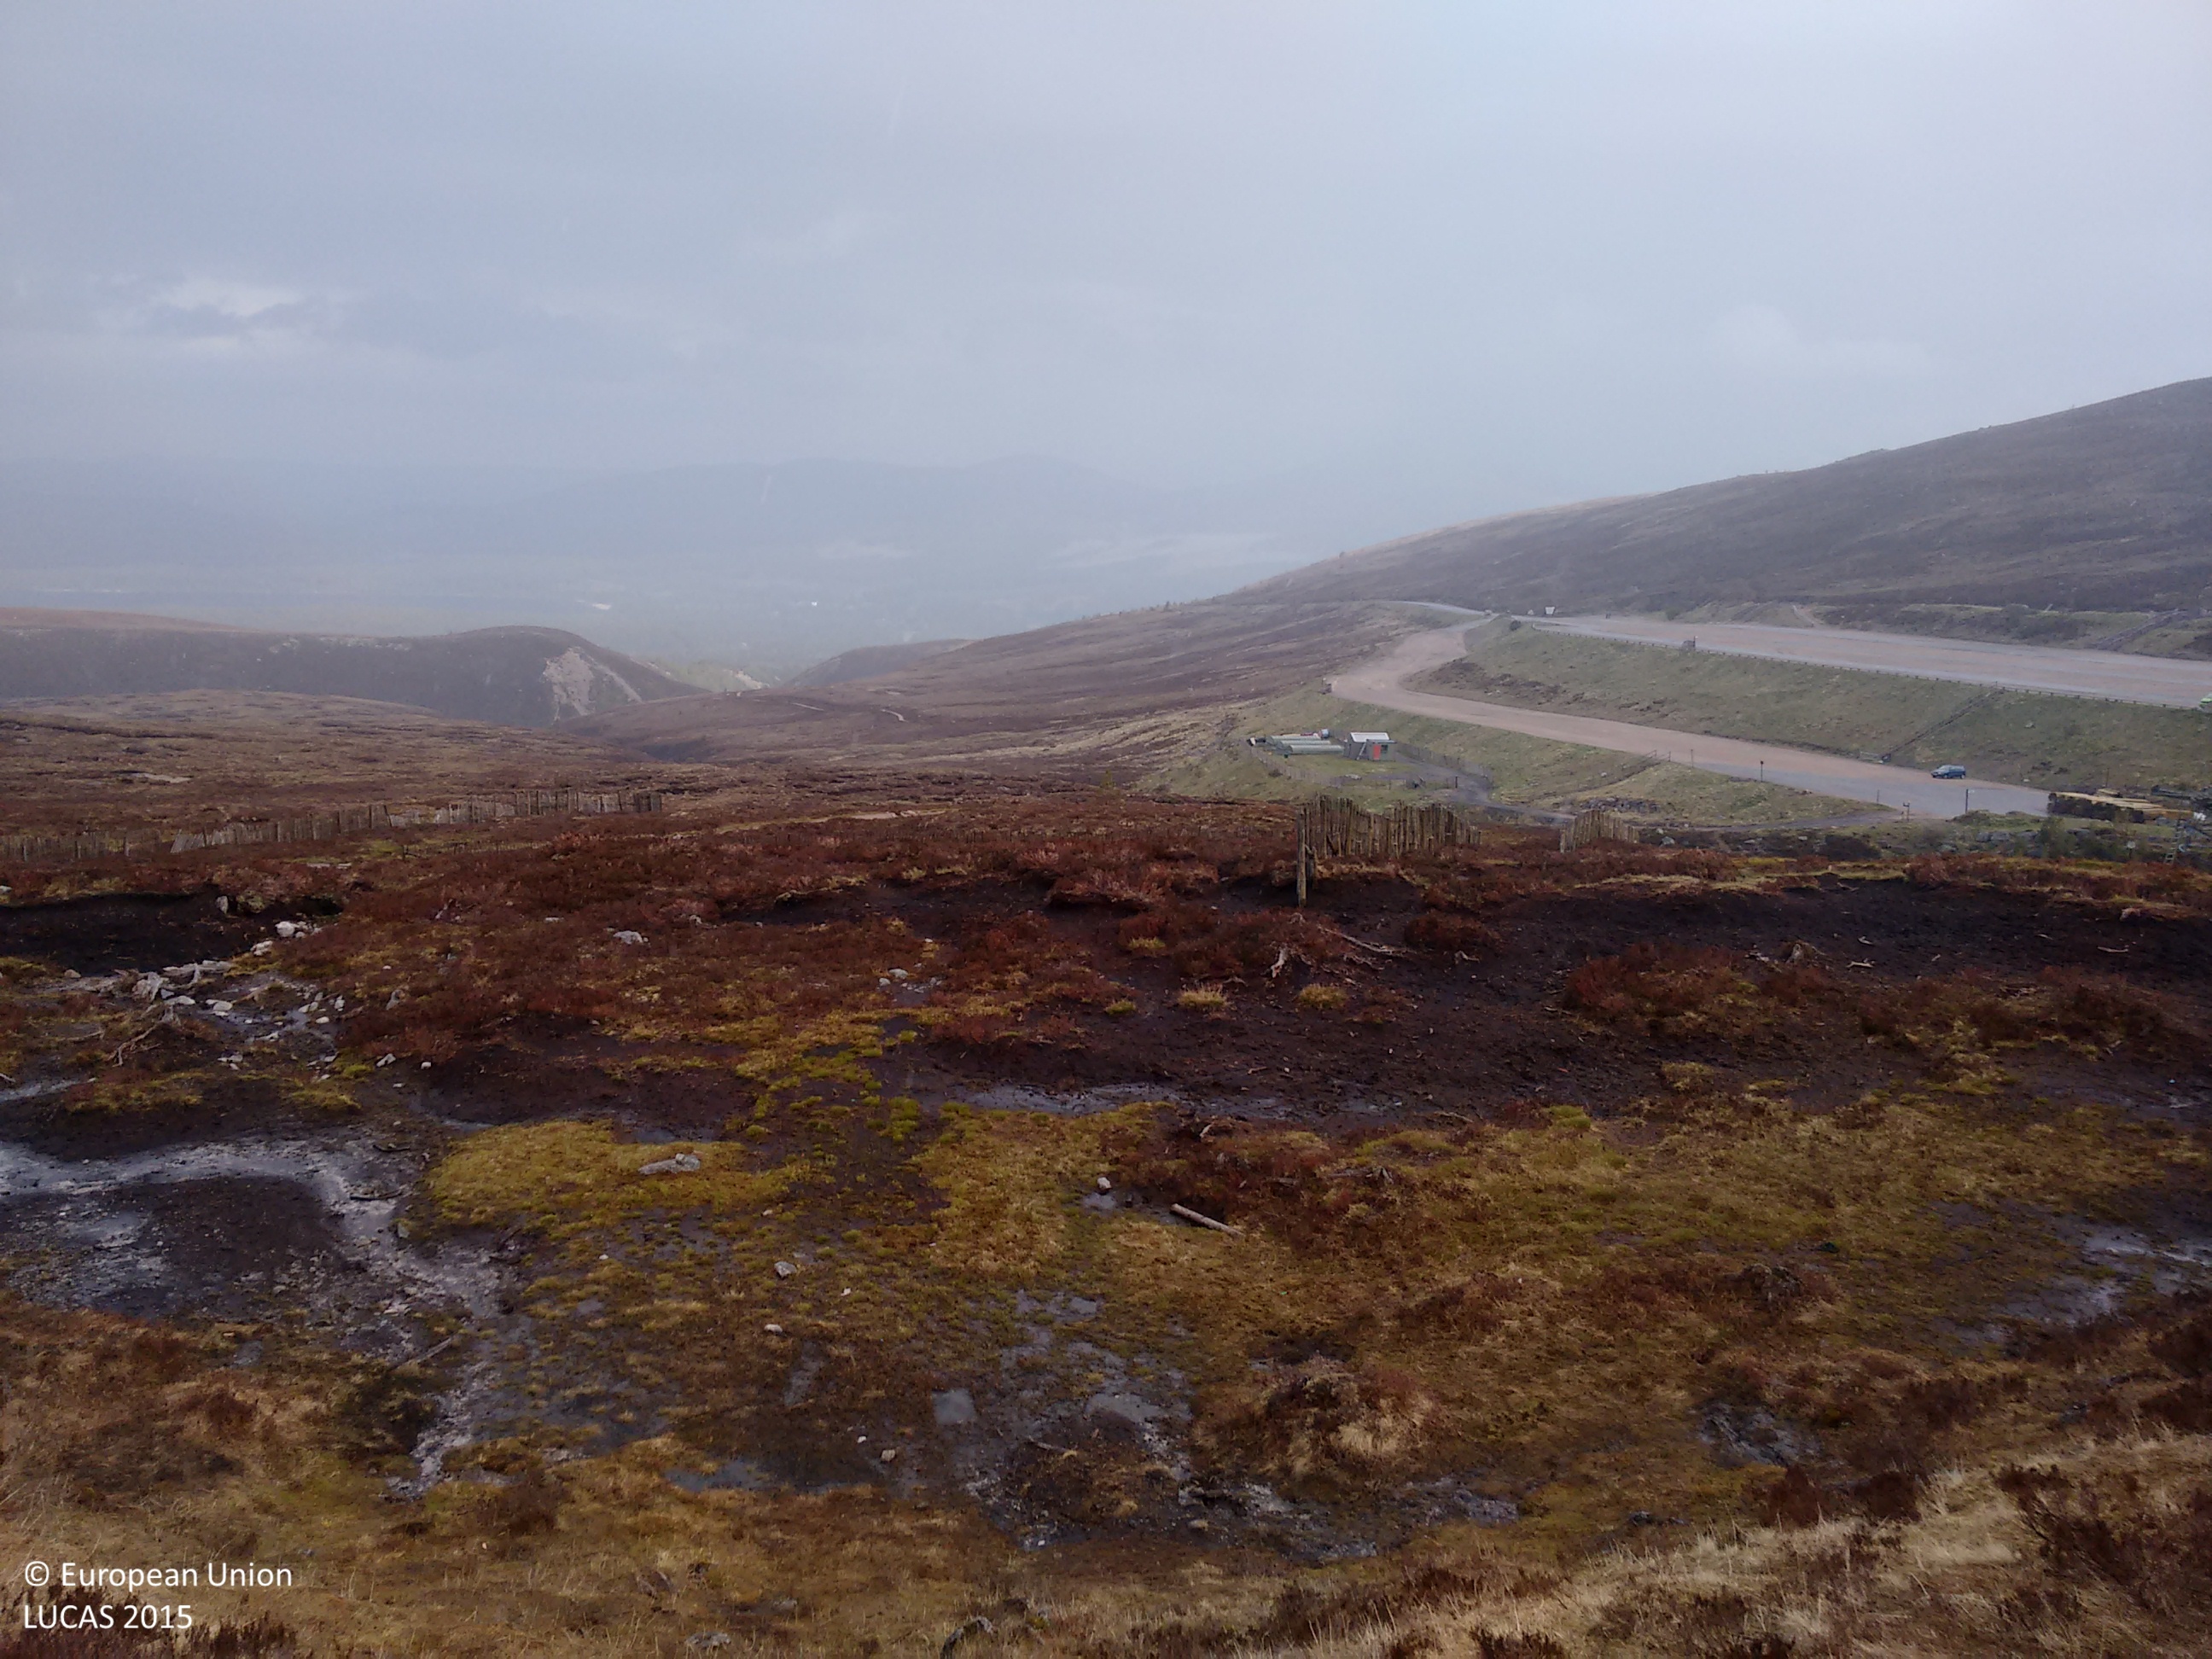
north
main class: Shrubland
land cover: Shrubland without tree cover
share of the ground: > 75 %
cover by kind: shrubs 55 %, herbaceous plants 40 %, unconsolidated bare surface 5 %
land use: Sport
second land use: Amenities, museums, leisure
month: June
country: GB
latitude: 57.1323
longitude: -3.6726
